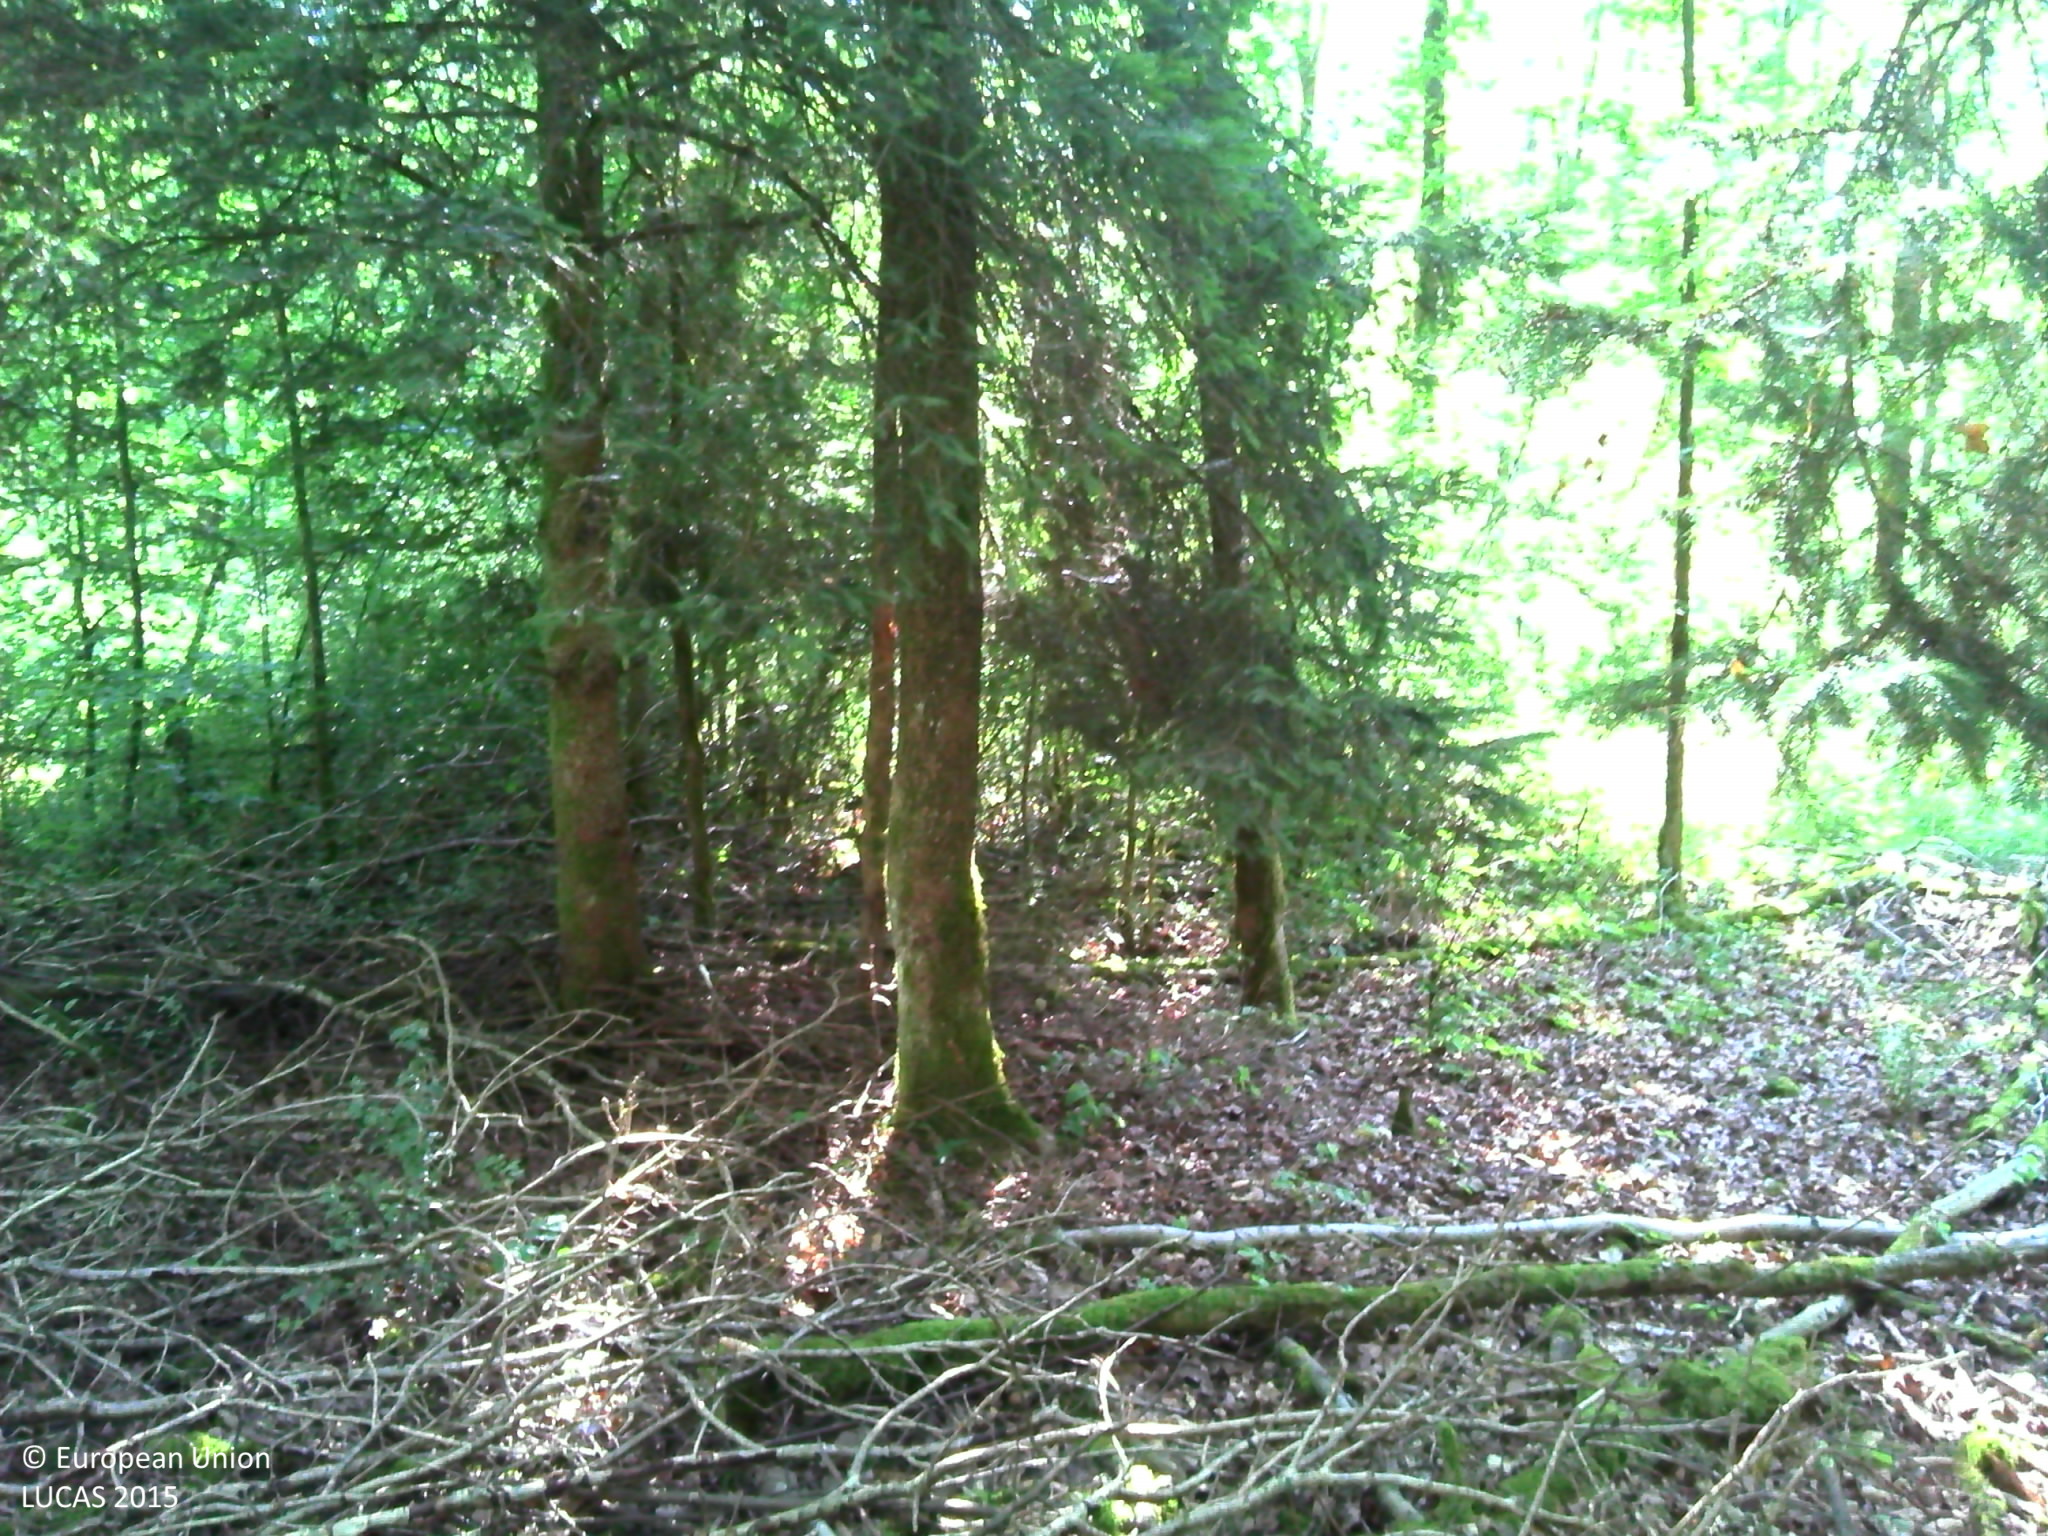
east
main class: Woodland
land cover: Broadleaved woodland
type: acidophilous oak and oak-birch forest
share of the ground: > 75 %
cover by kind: broadleaved forest trees 90 %, coniferous forest trees 10 %
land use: Forestry
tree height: > 5 m
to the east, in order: Broadleaved woodland; Tracks; Broadleaved woodland
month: July
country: BE
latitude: 49.6831
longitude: 5.5495
